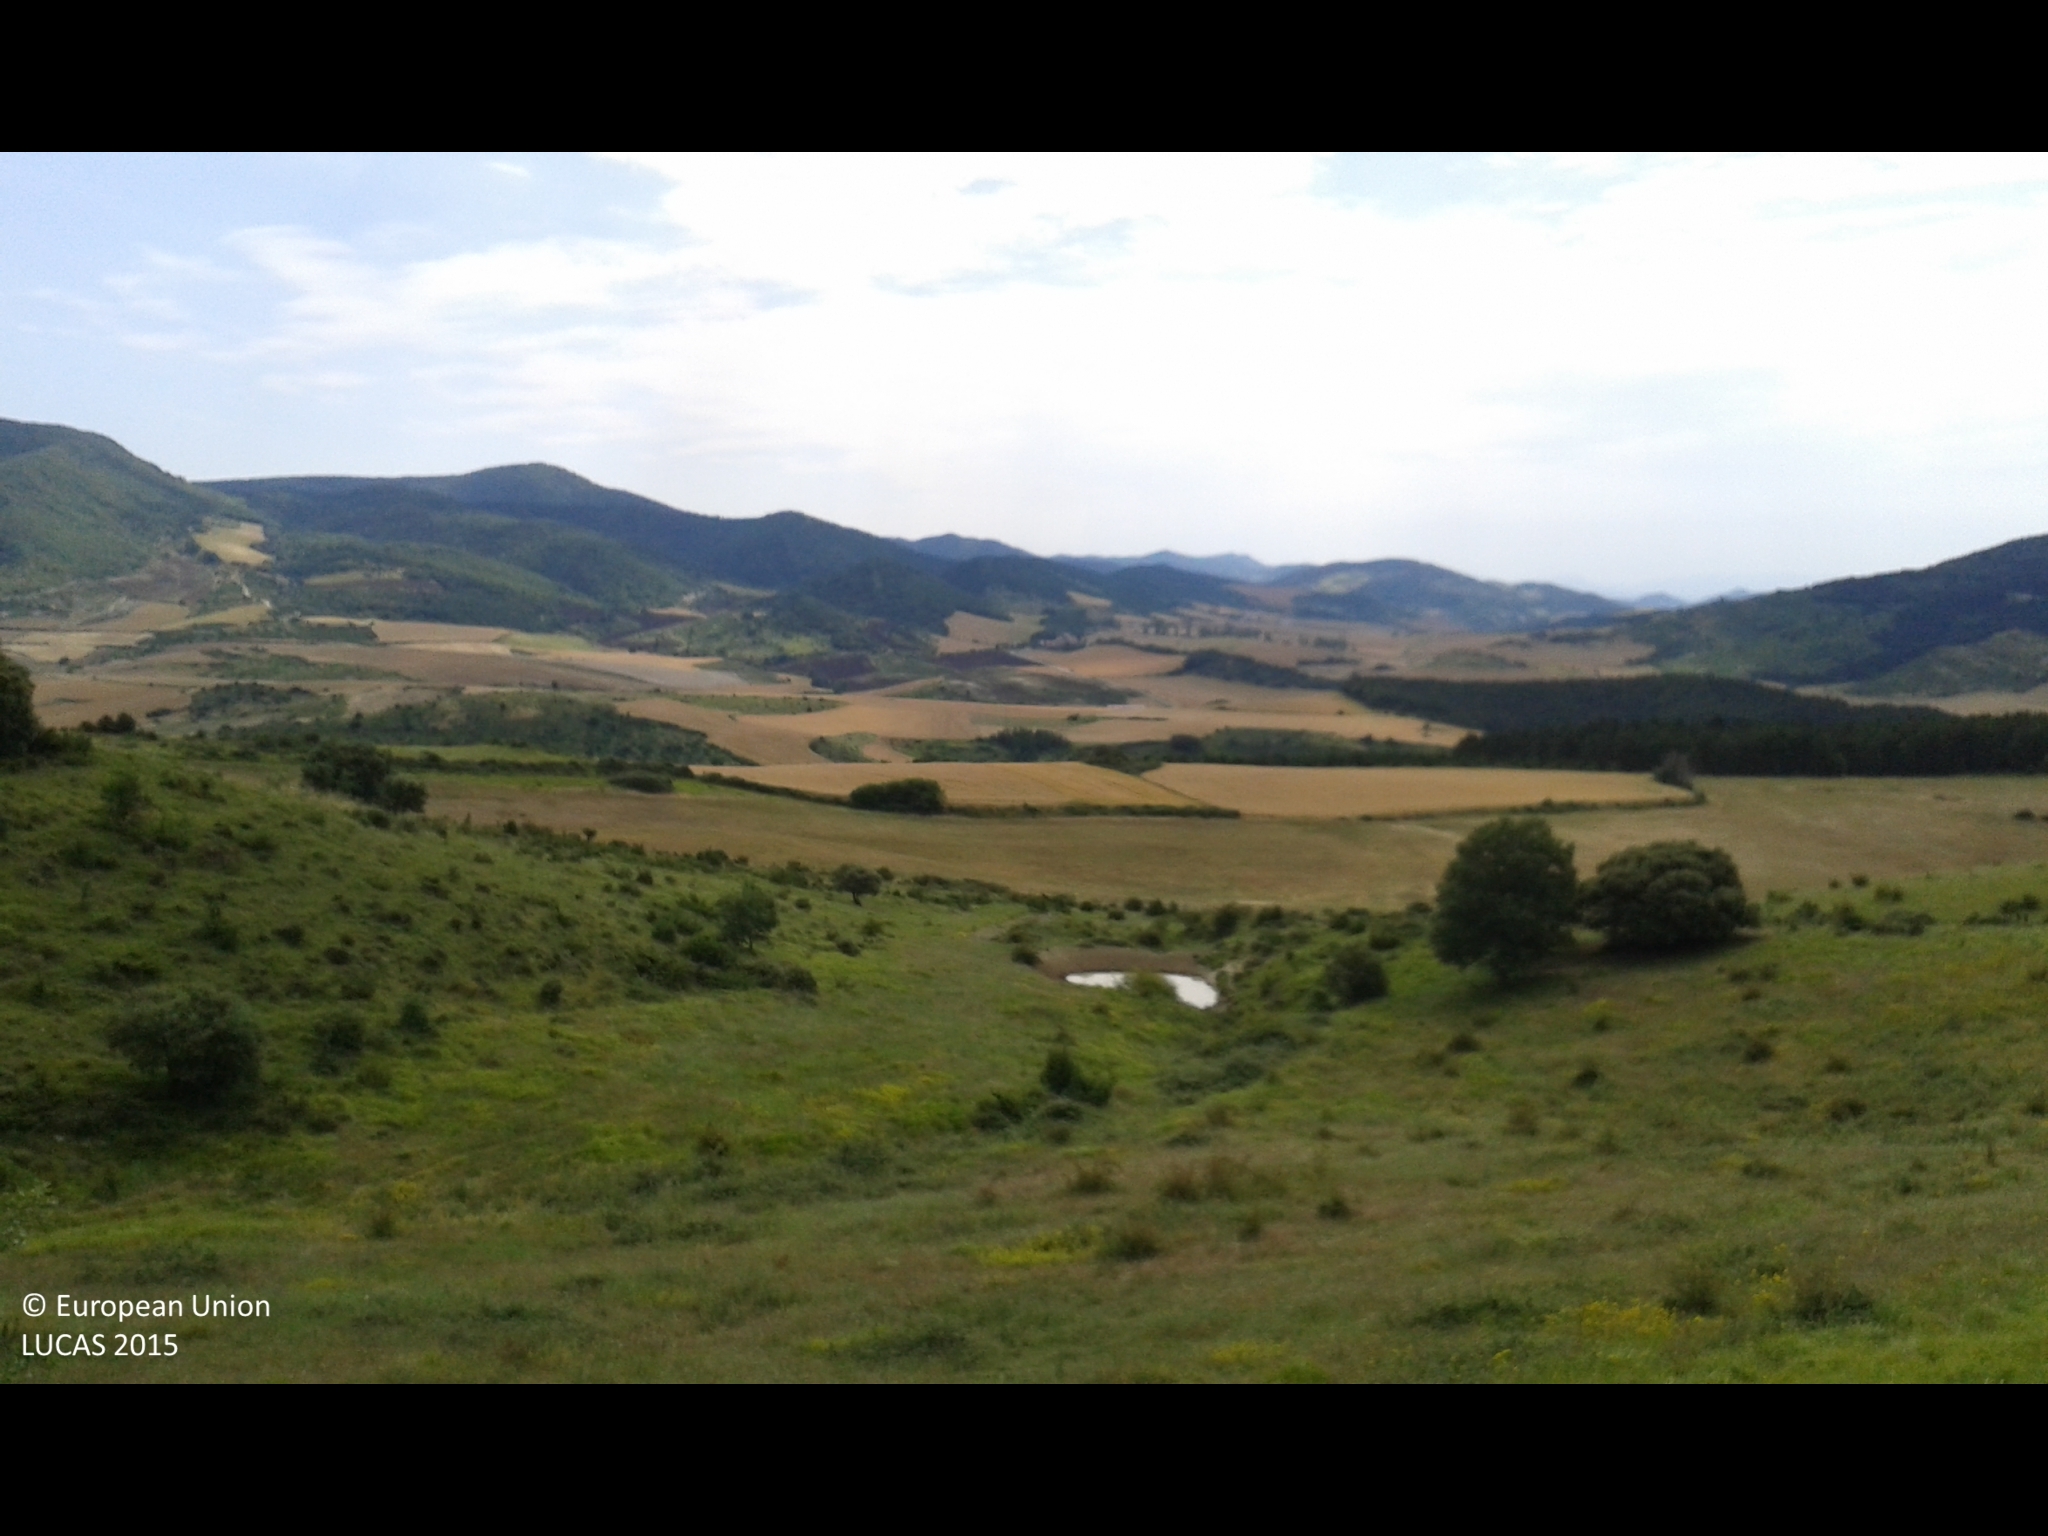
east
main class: Shrubland
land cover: Shrubland with sparse tree cover
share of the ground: > 75 %
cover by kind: herbaceous plants 75 %, shrubs 20 %, broadleaved forest trees 5 %
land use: Agriculture (excluding fallow land and kitchen gardens)
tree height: < 5 m
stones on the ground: < 10 %
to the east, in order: Shrubland with sparse tree cover; Shrubland without tree cover; Fences; Shrubland without tree cover
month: June
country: ES
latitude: 42.8838
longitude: -1.7086
